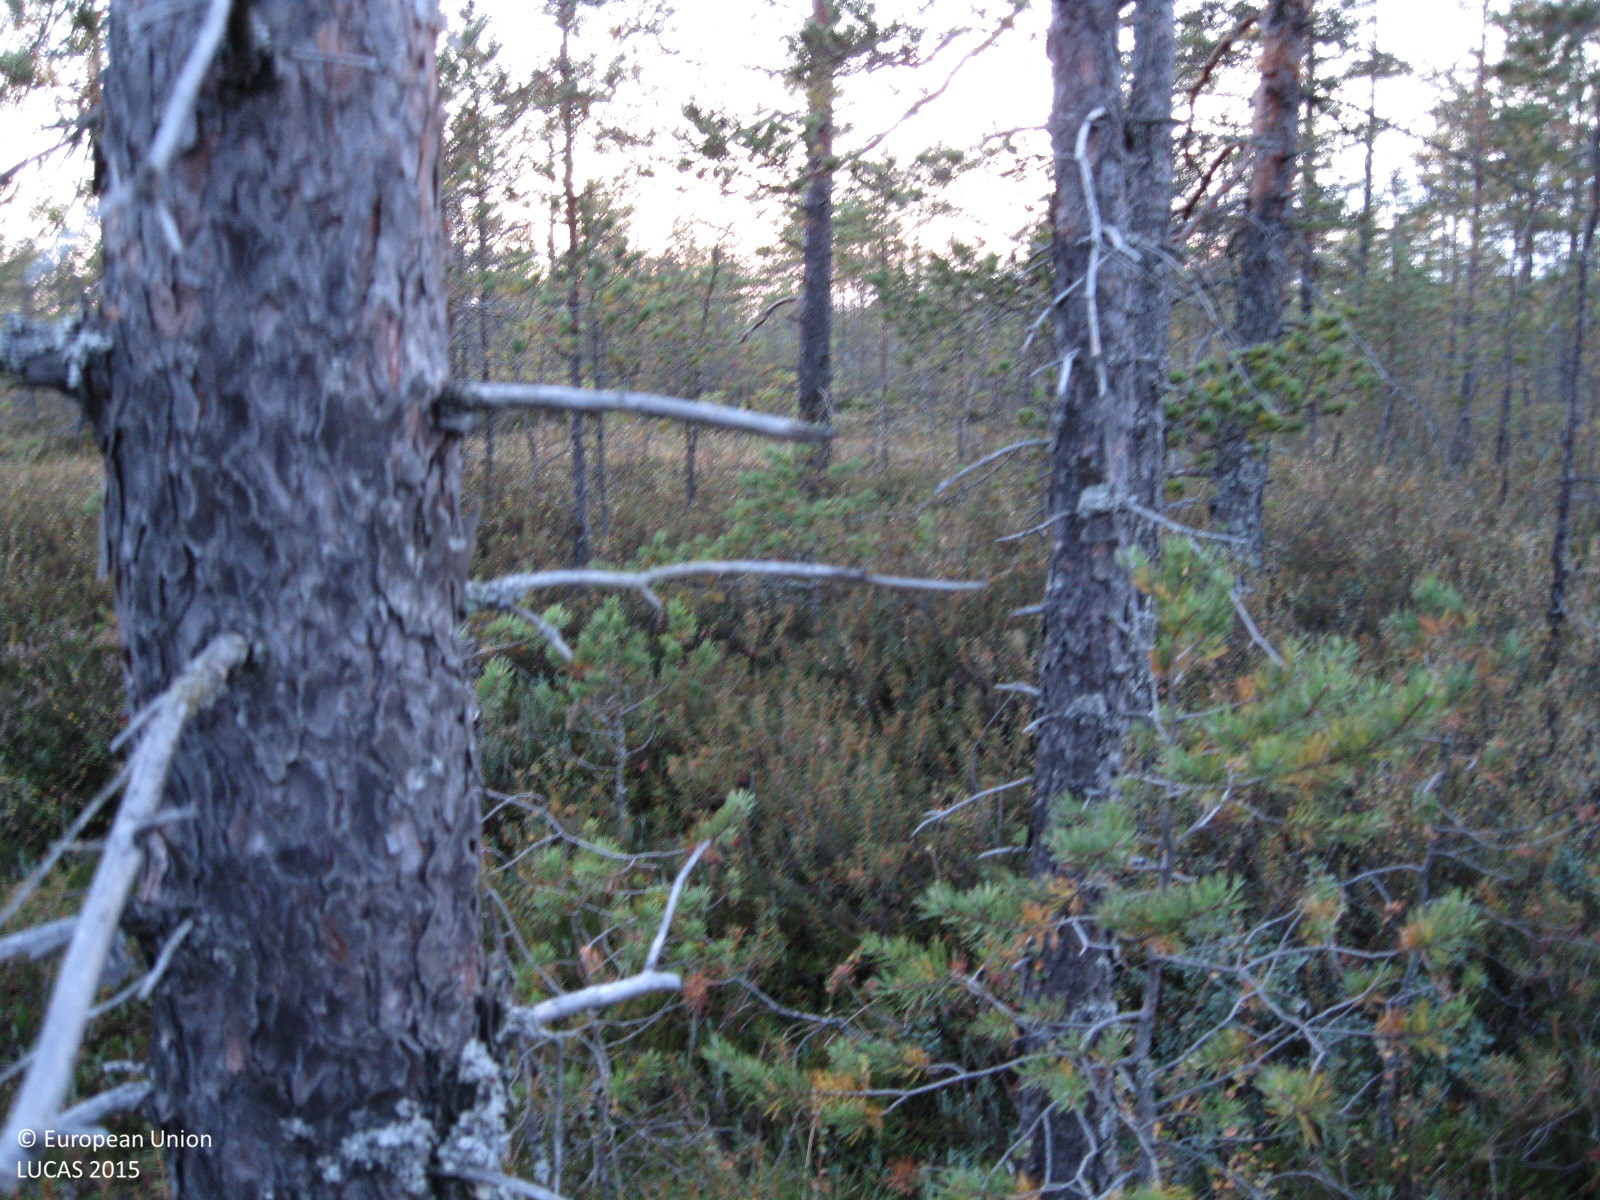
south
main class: Woodland
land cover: Pine dominated coniferous woodland
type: mire and swamp forests
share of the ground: 25 - 50 %
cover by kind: coniferous forest trees 45 %, shrubs 35 %, lichens and mosses 20 %
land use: Semi-natural and natural areas not in use
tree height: > 5 m
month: September
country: FI
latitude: 60.5906
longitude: 24.7715
